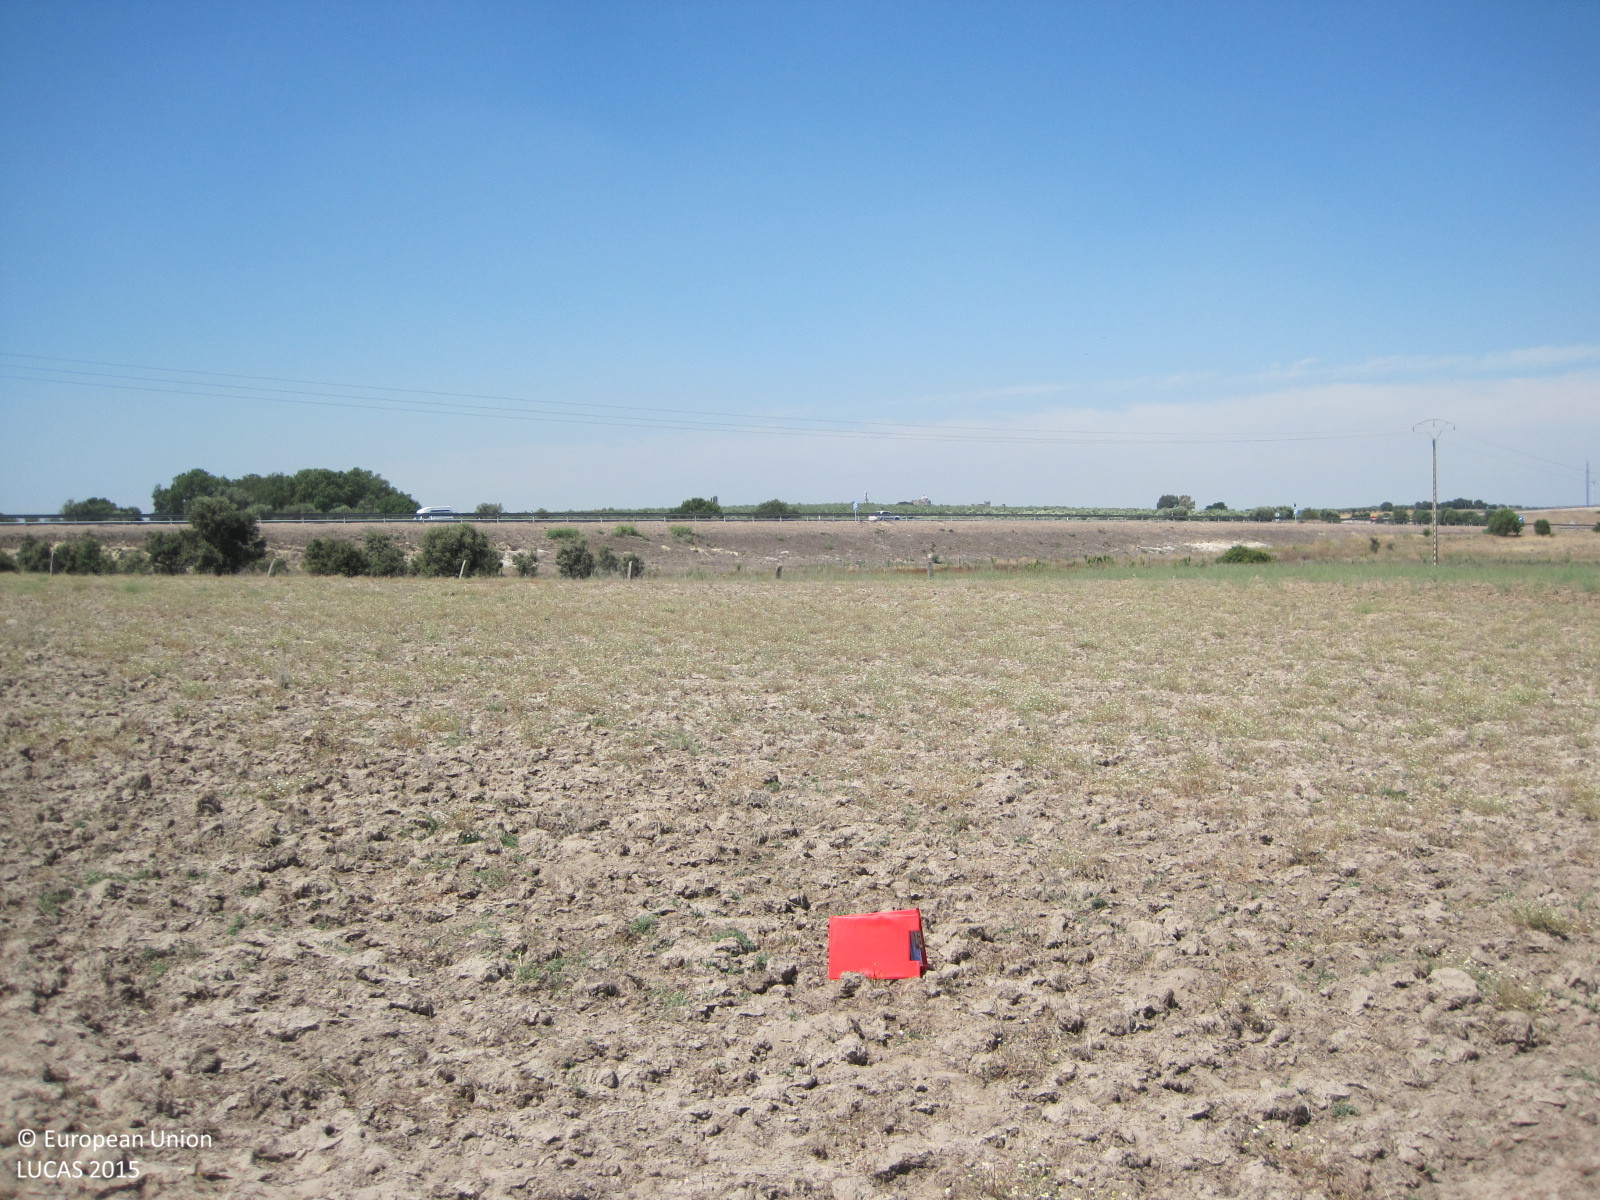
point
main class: Grassland
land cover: Spontaneously vegetated surfaces
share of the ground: > 75 %
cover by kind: herbaceous plants 90 %, unconsolidated bare surface 10 %
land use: Fallow land
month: July
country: ES
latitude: 39.9305
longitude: -5.1355
